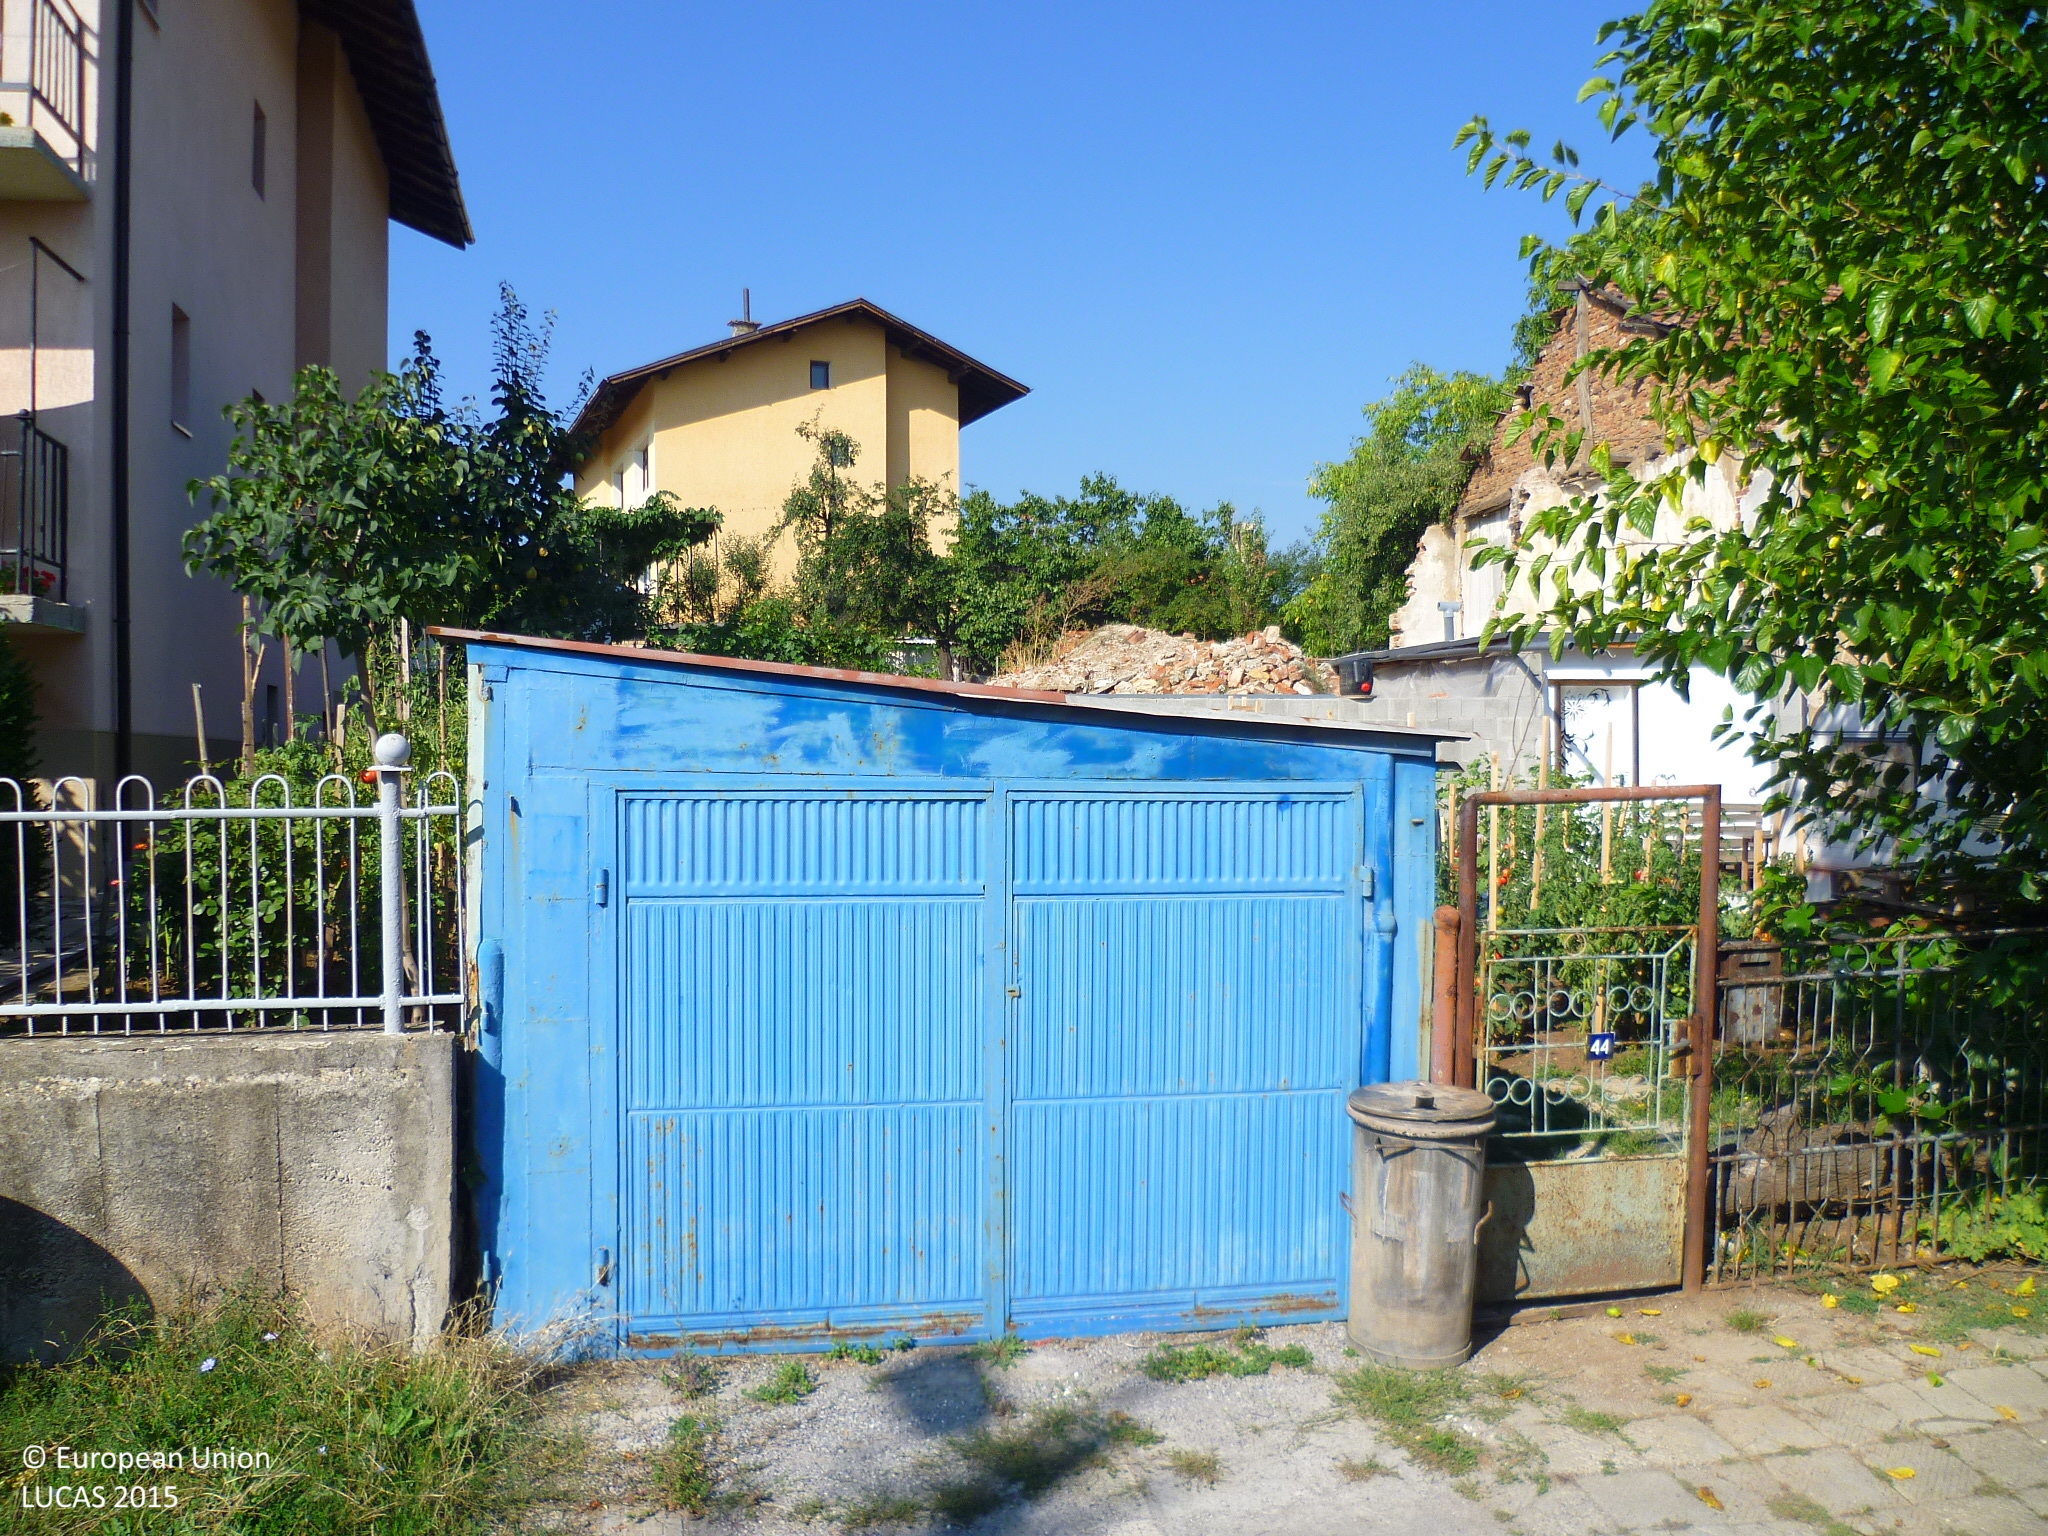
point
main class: Woodland
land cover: Broadleaved woodland
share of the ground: > 75 %
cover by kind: broadleaved forest trees 100 %
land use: Residential
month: September
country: BG
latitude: 42.5936
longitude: 23.0324
